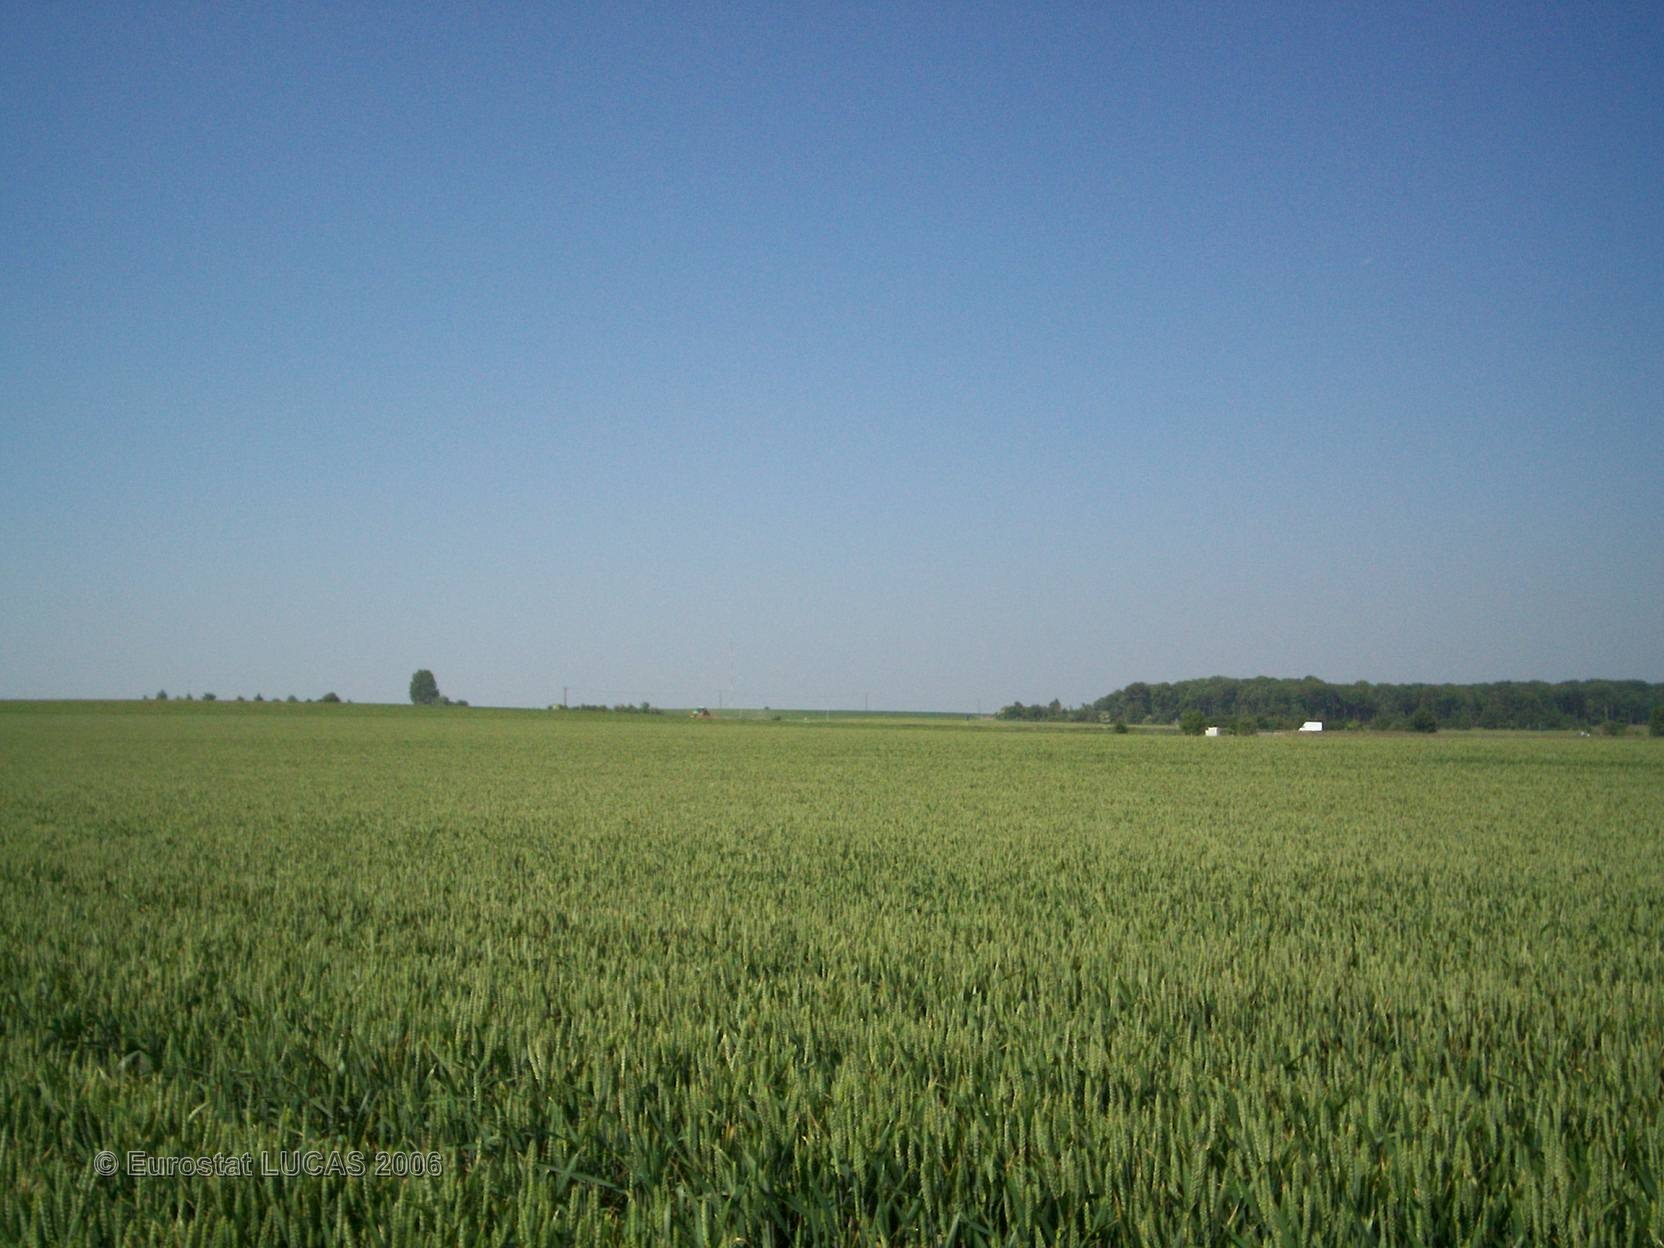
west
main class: Cropland
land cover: Common wheat
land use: Agriculture (excluding fallow land and kitchen gardens)
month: June
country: FR
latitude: 49.5352
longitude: 2.7070
